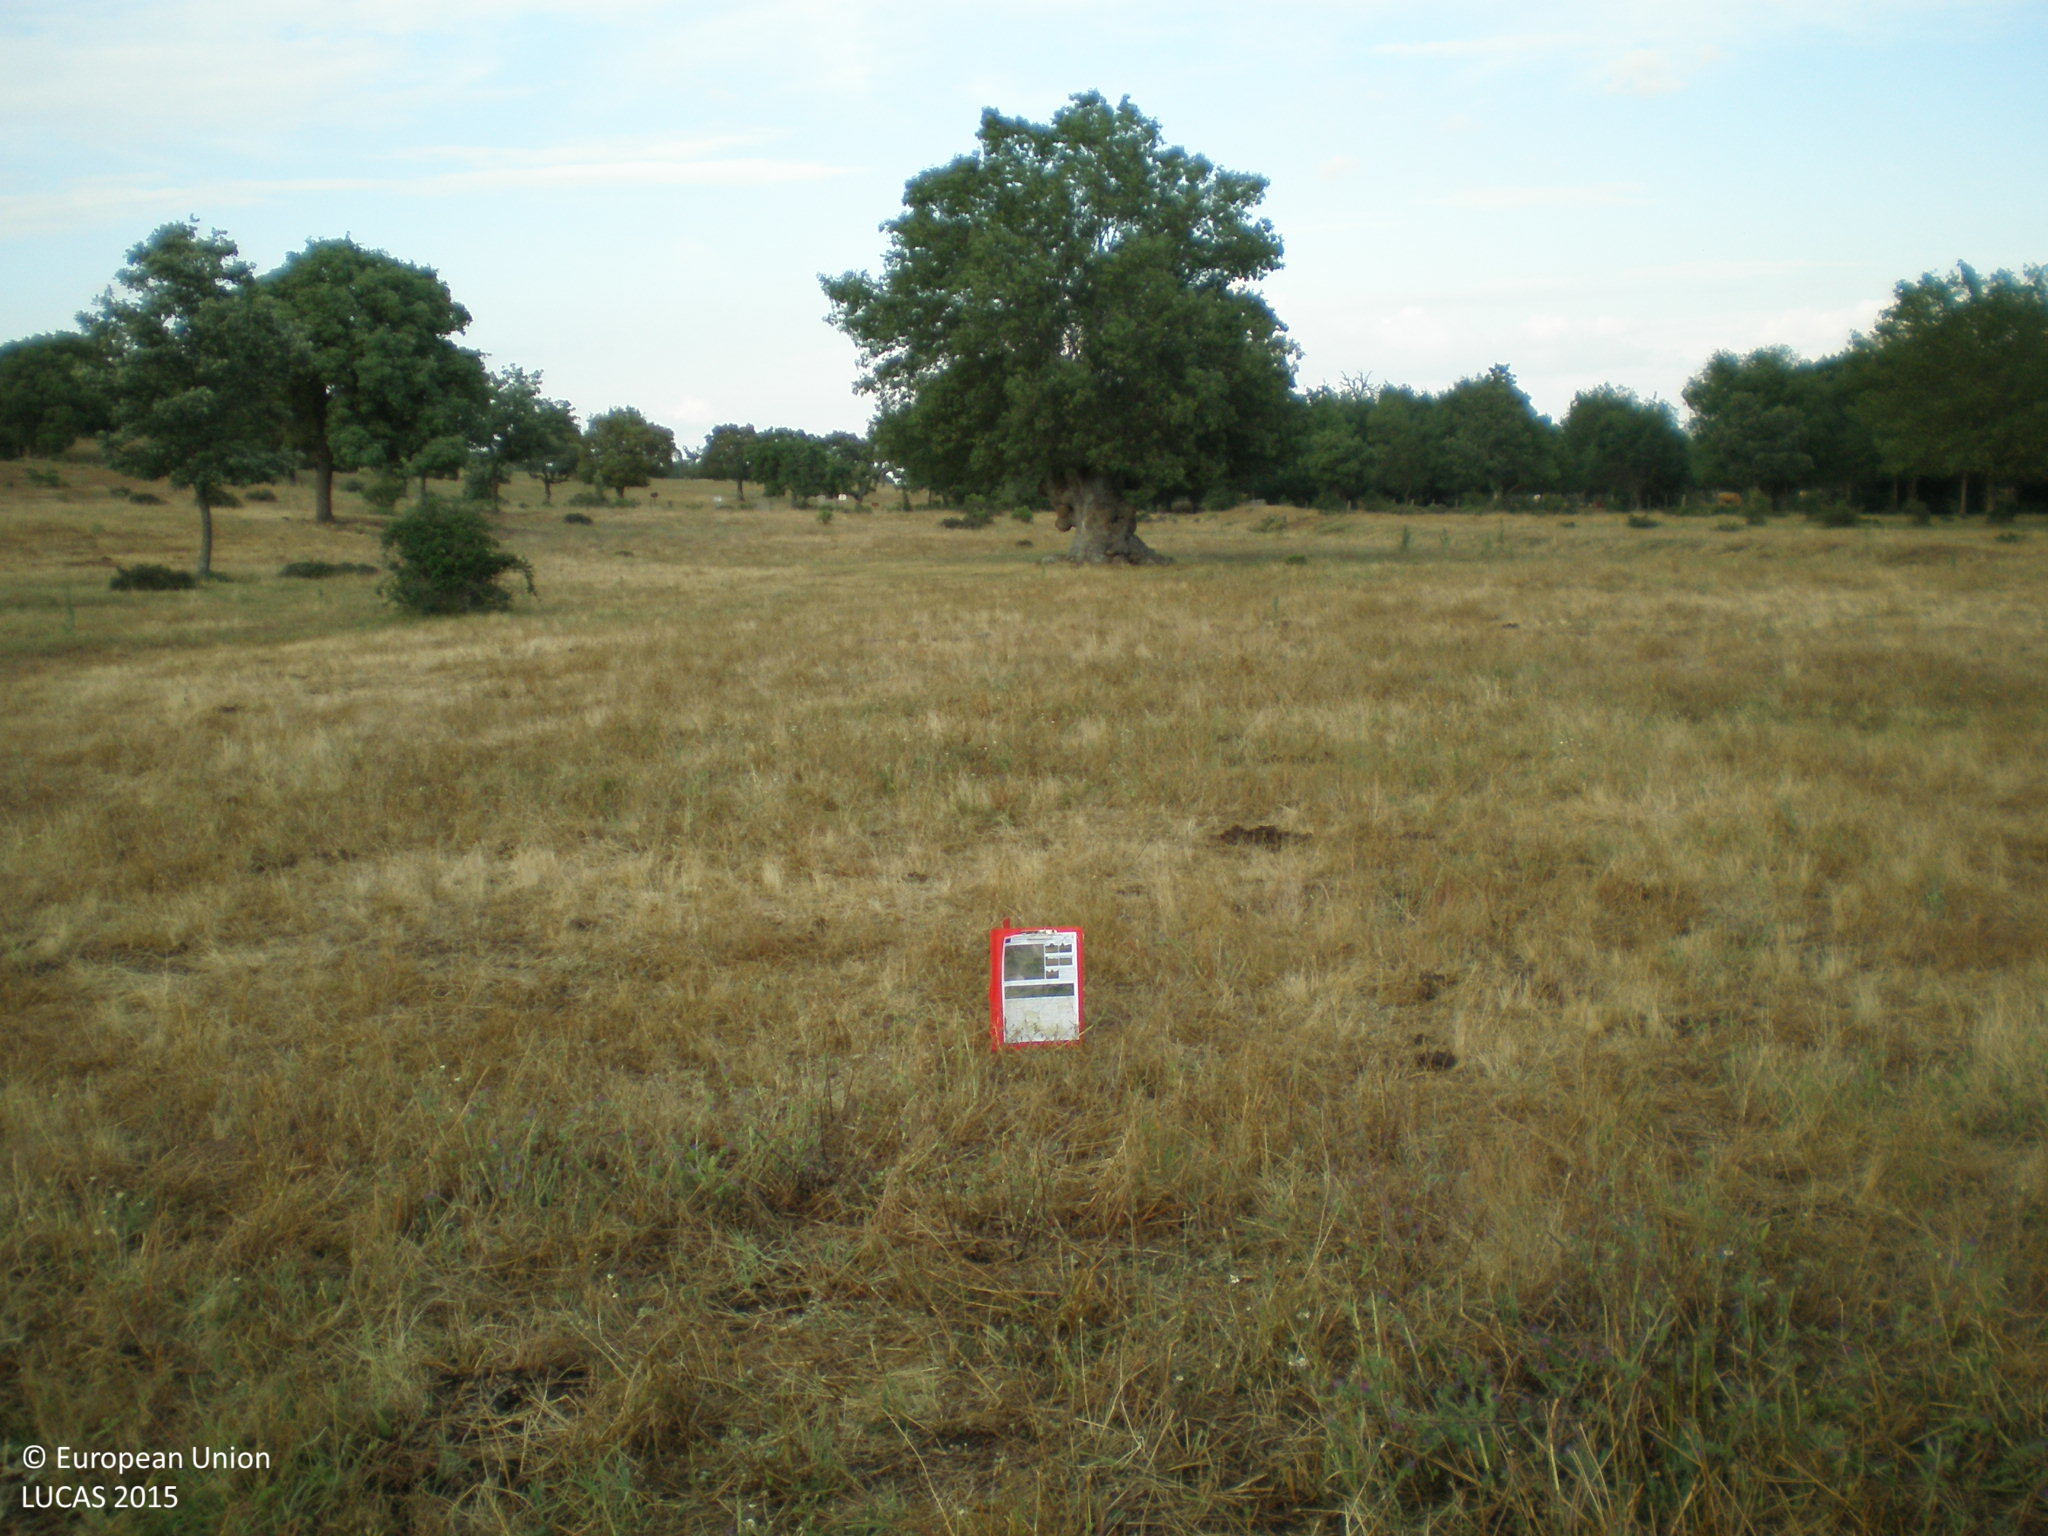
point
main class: Grassland
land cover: Grassland without tree/shrub cover
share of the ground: > 75 %
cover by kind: herbaceous plants 100 %
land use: Agriculture (excluding fallow land and kitchen gardens)
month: June
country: ES
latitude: 41.2082
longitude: -5.7655
